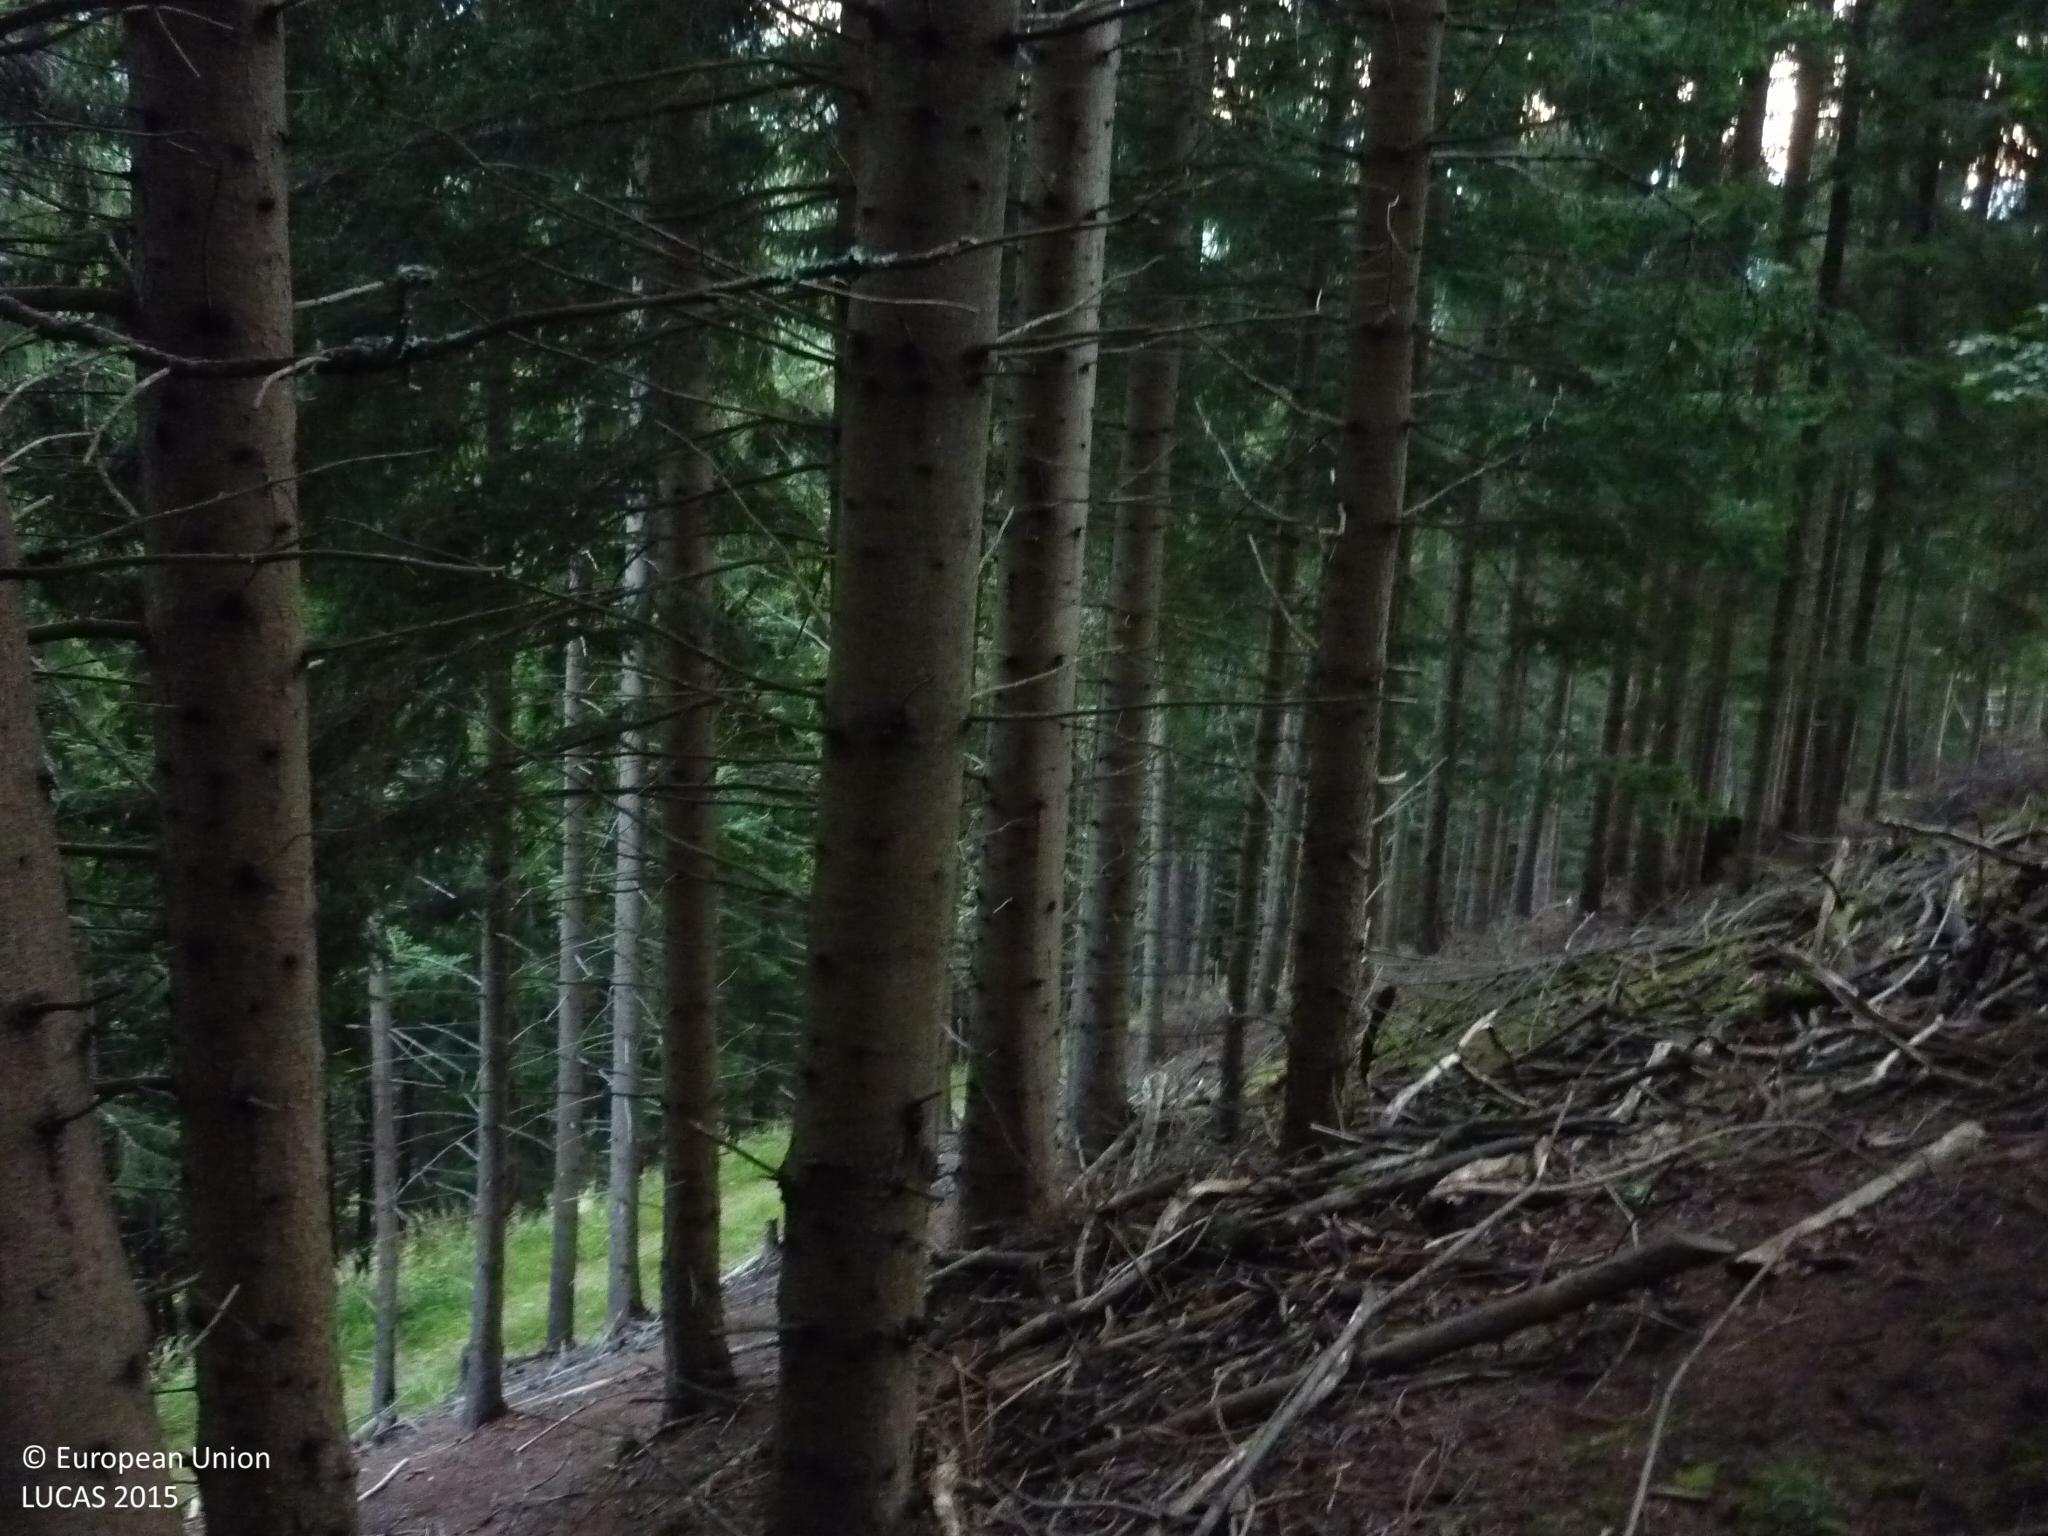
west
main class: Woodland
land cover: Spruce dominated coniferous woodland
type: alpine coniferous forest
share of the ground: > 75 %
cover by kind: coniferous forest trees 85 %, unconsolidated bare surface 10 %, herbaceous plants 5 %
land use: Forestry
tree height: > 5 m
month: August
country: AT
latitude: 46.8853
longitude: 13.6064
